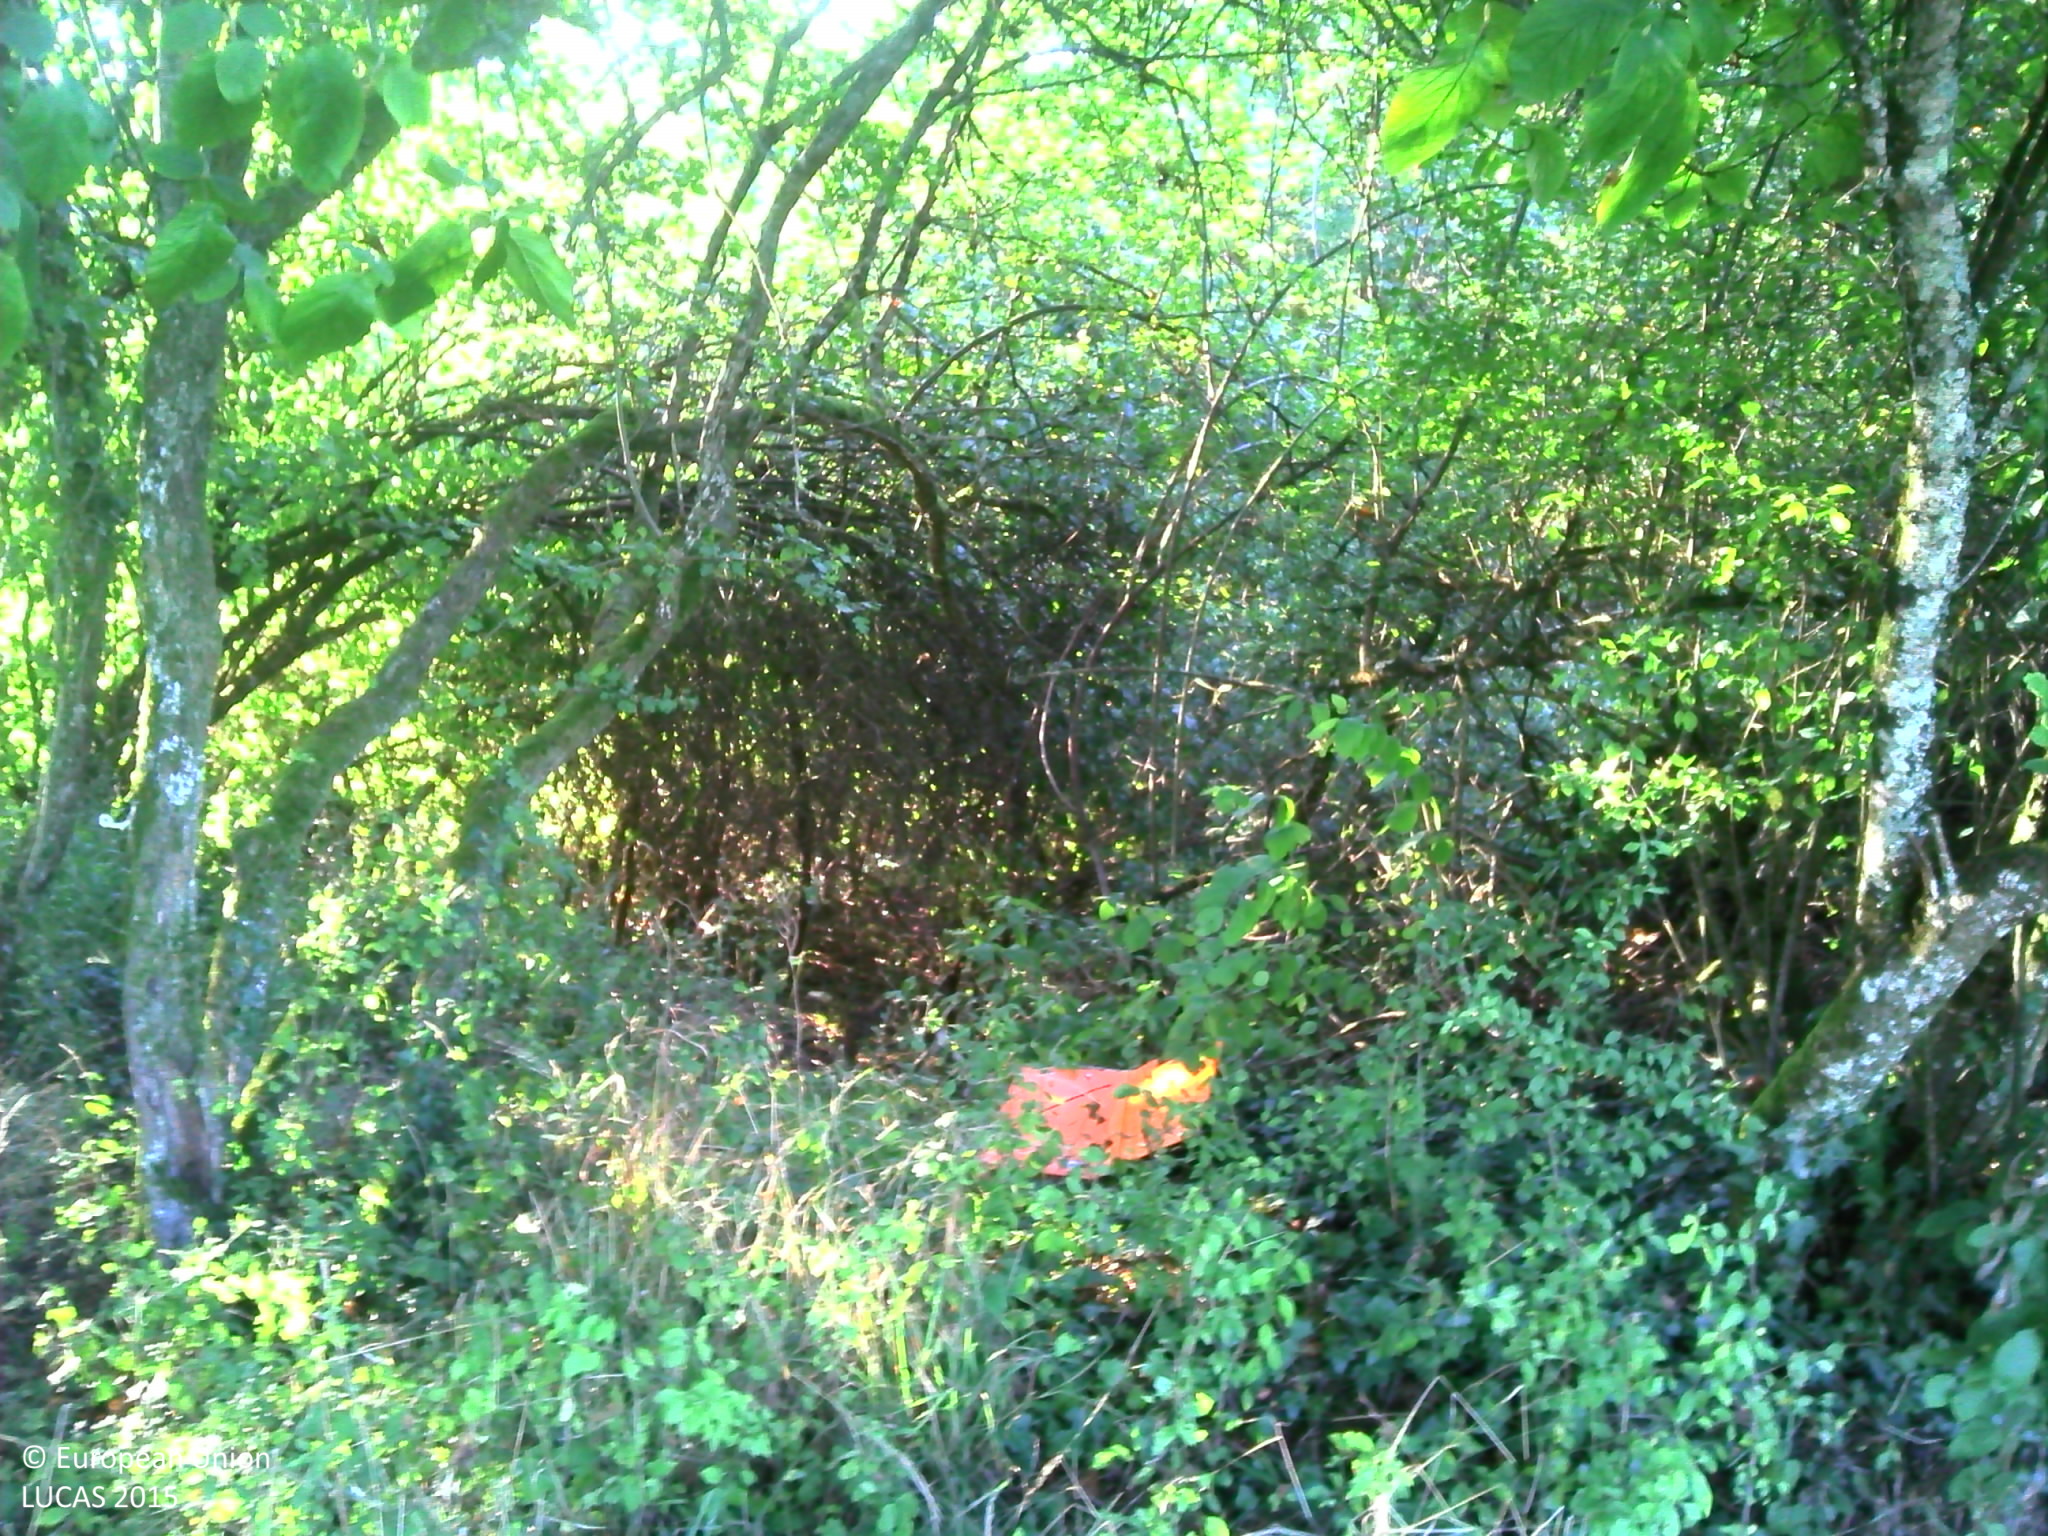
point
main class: Woodland
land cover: Broadleaved woodland
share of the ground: > 75 %
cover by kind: broadleaved forest trees 80 %, herbaceous plants 20 %
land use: Agriculture (excluding fallow land and kitchen gardens)
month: September
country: FR
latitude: 47.3150
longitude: 6.3109
